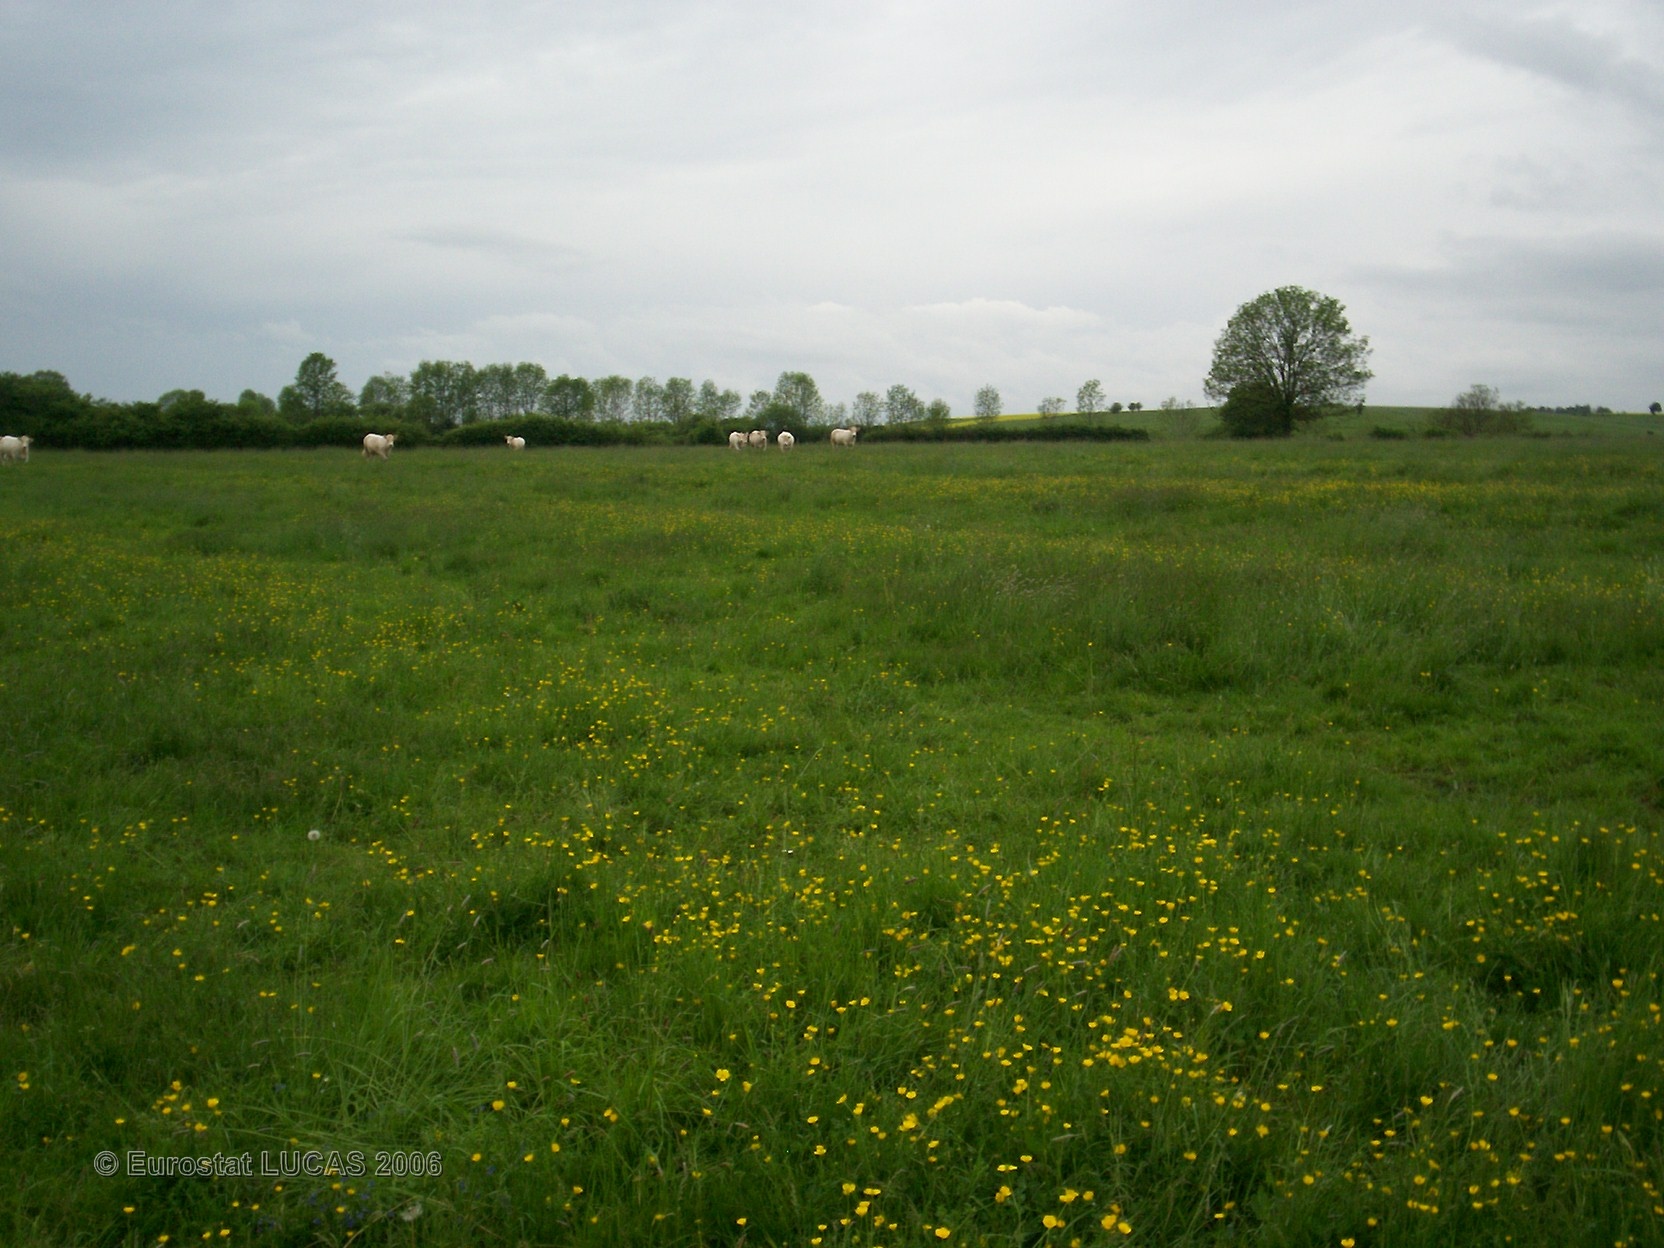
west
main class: Grassland
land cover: Grassland without tree/shrub cover
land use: Agriculture (excluding fallow land and kitchen gardens)
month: May
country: FR
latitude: 47.2087
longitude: 4.6265
